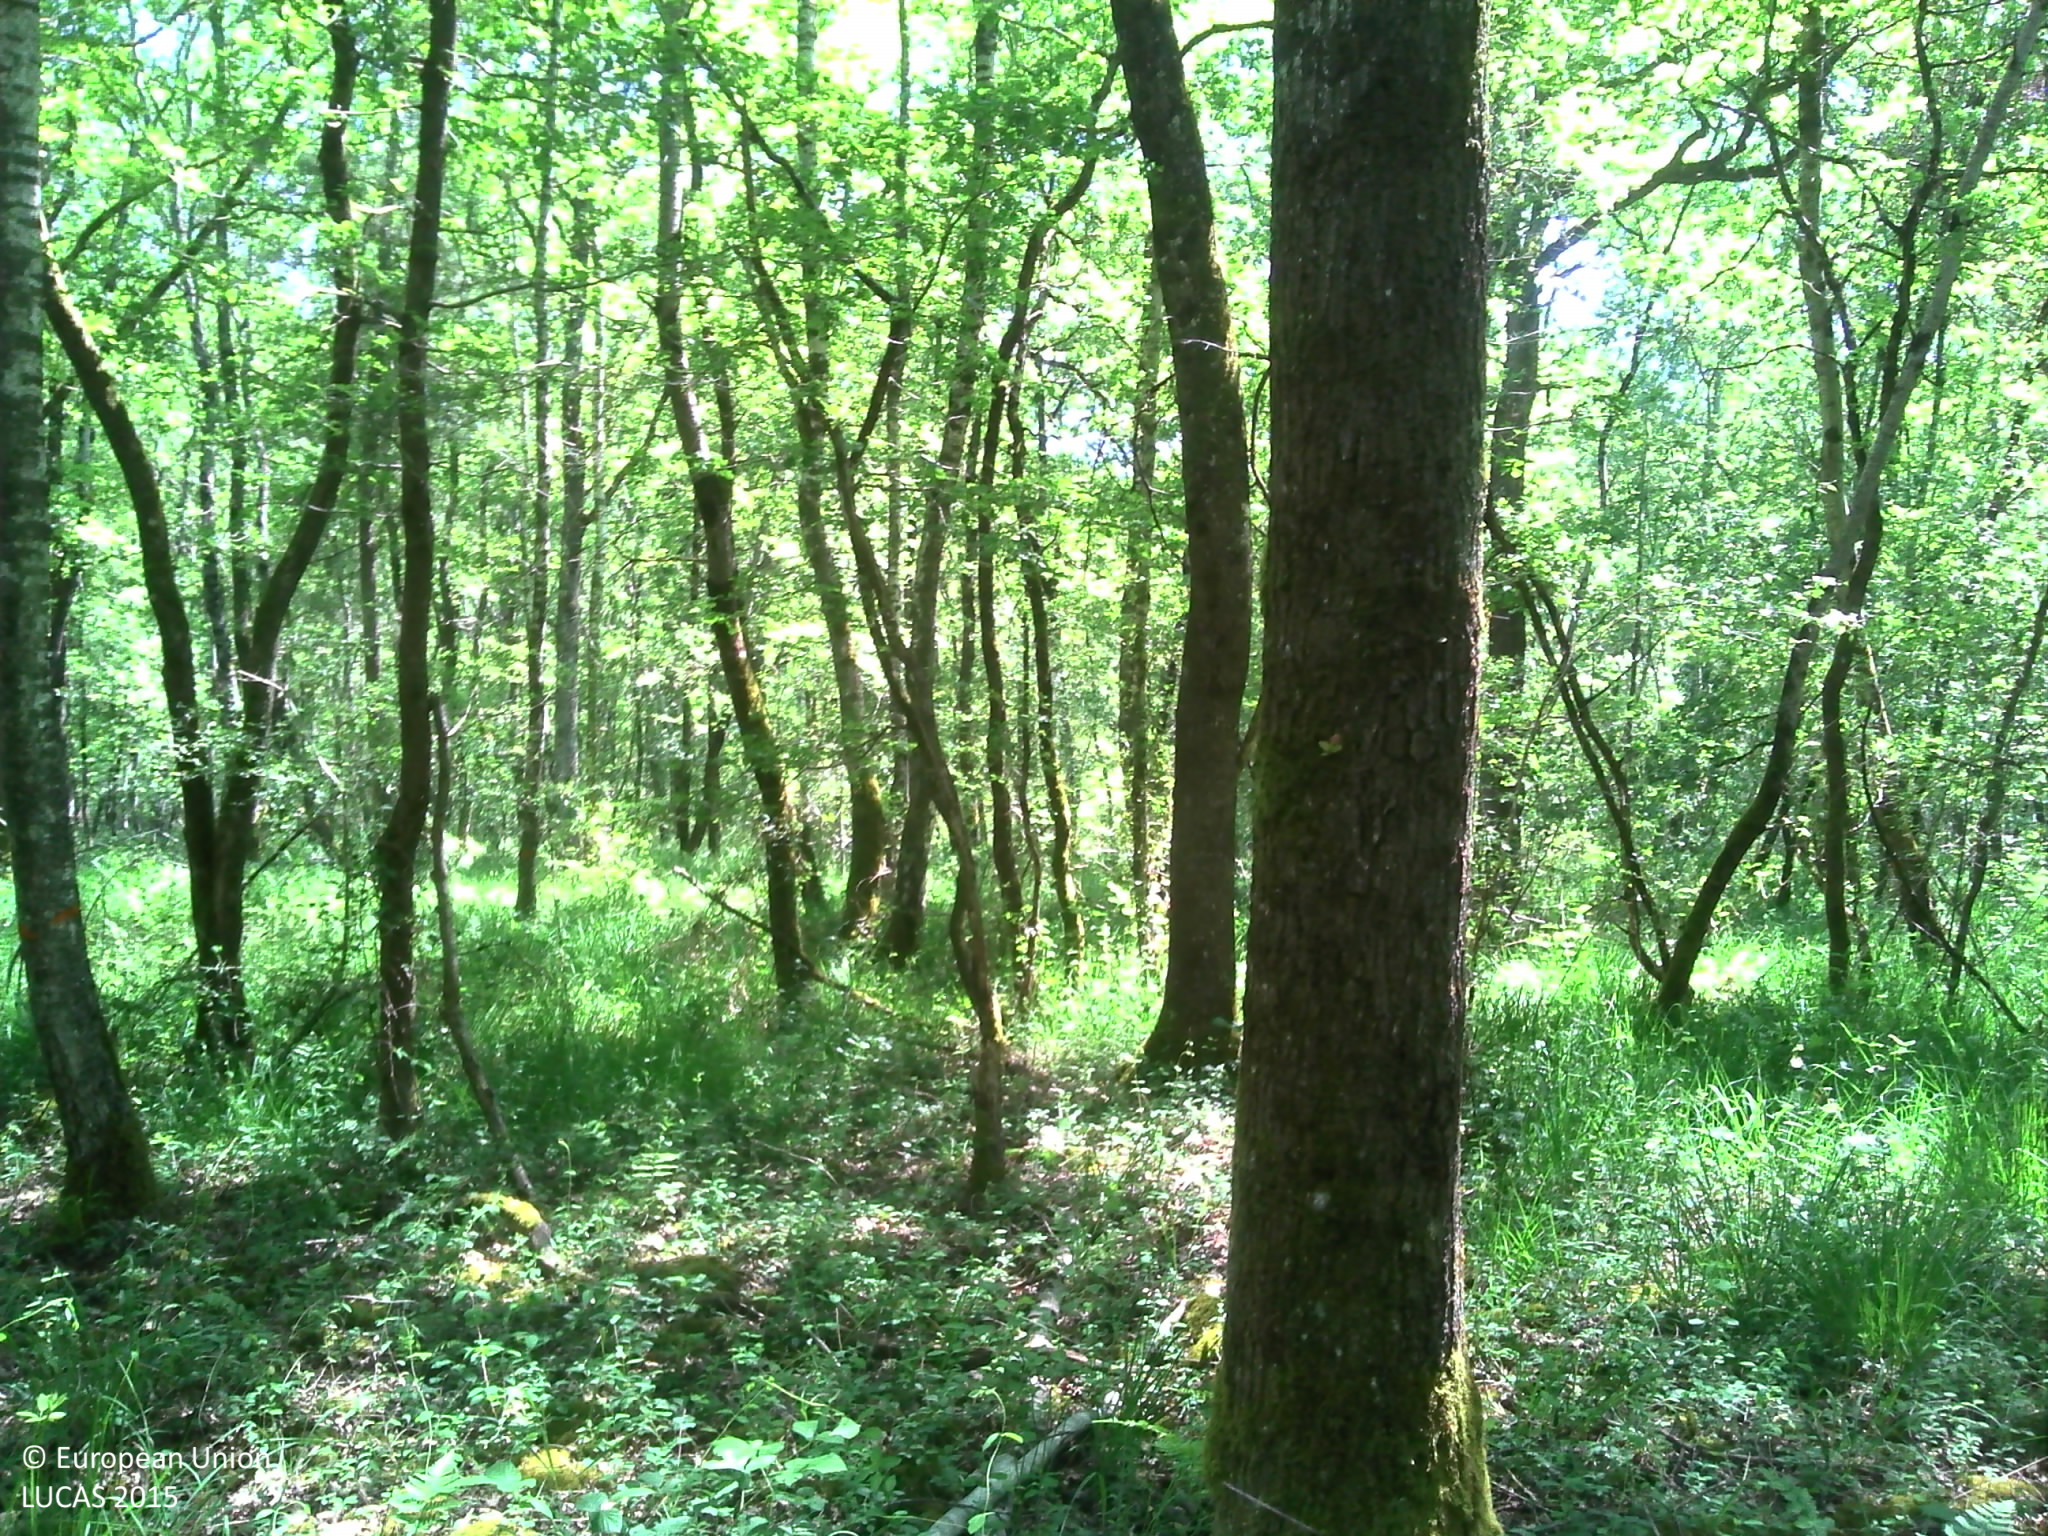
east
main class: Woodland
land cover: Broadleaved woodland
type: thermophilous deciduous forest
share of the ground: > 75 %
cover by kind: broadleaved forest trees 80 %, herbaceous plants 20 %
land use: Forestry
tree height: > 5 m
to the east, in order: Broadleaved woodland
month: June
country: FR
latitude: 46.6201
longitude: 4.7648
